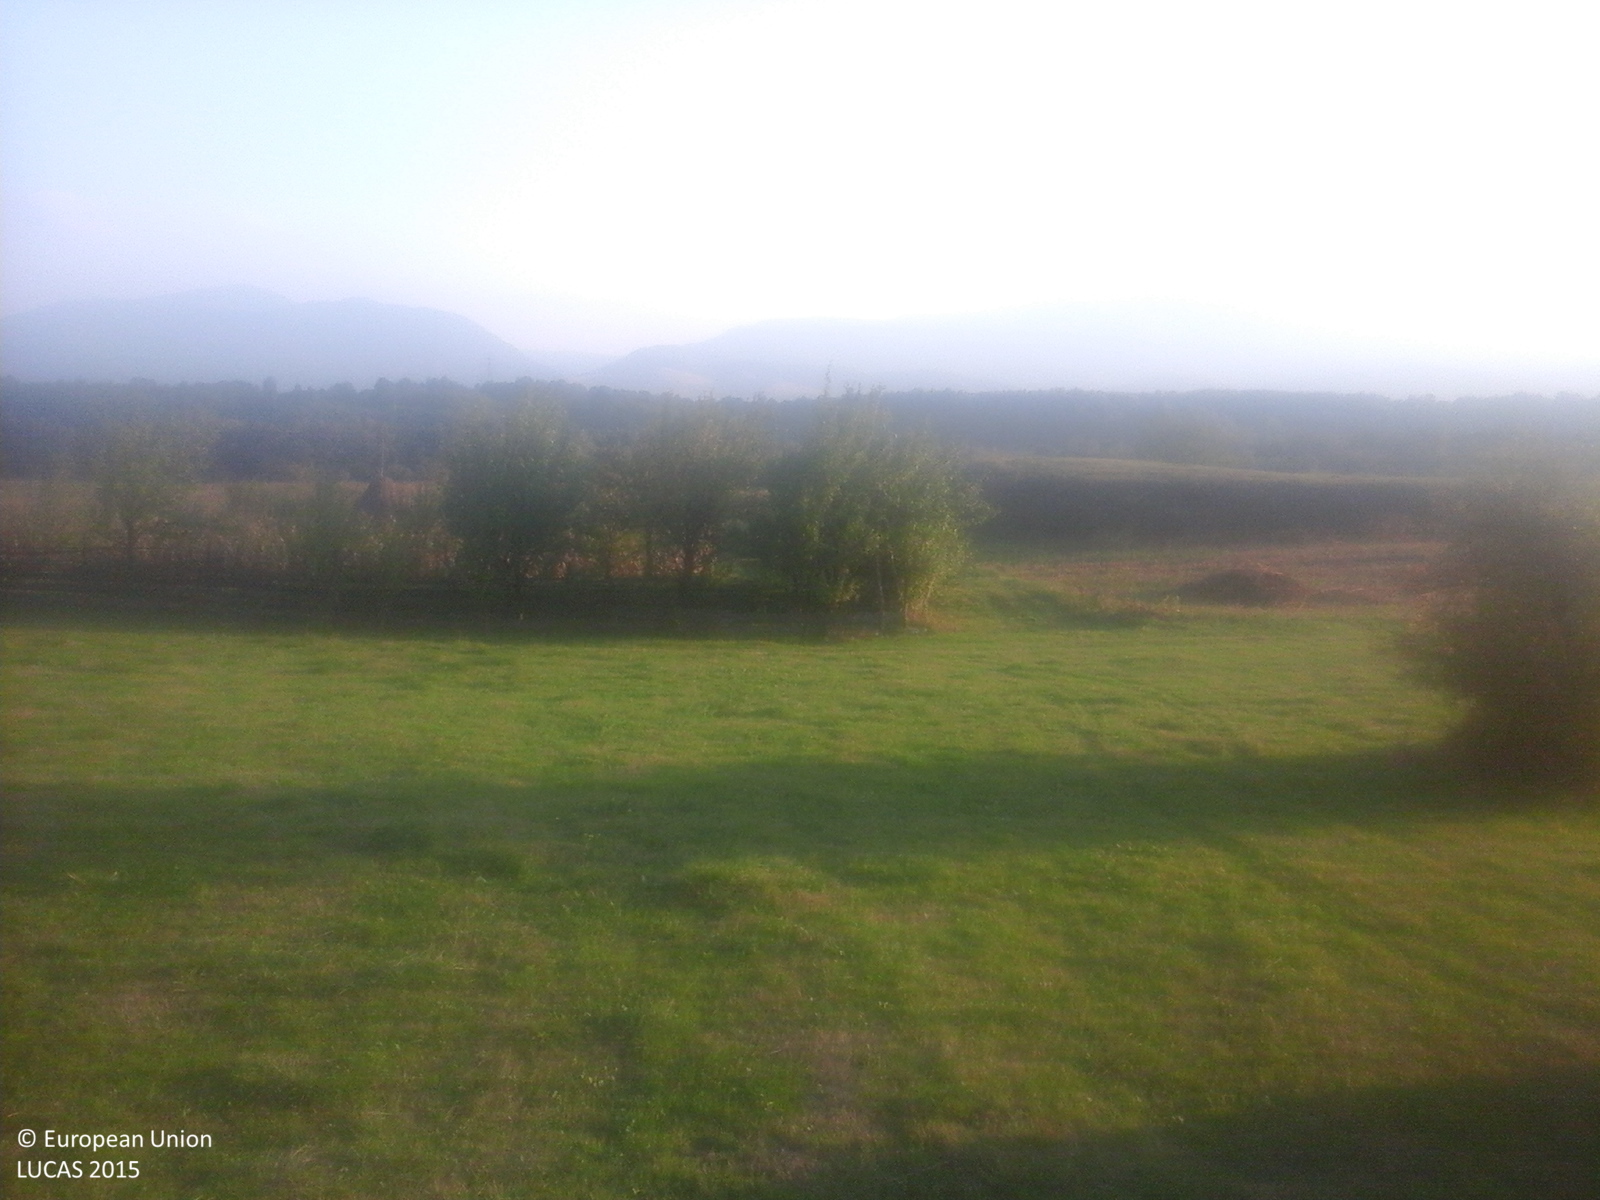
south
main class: Grassland
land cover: Grassland without tree/shrub cover
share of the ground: > 75 %
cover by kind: herbaceous plants 100 %
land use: Agriculture (excluding fallow land and kitchen gardens)
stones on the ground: < 10 %
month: September
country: RO
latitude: 45.5263
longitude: 23.0755
